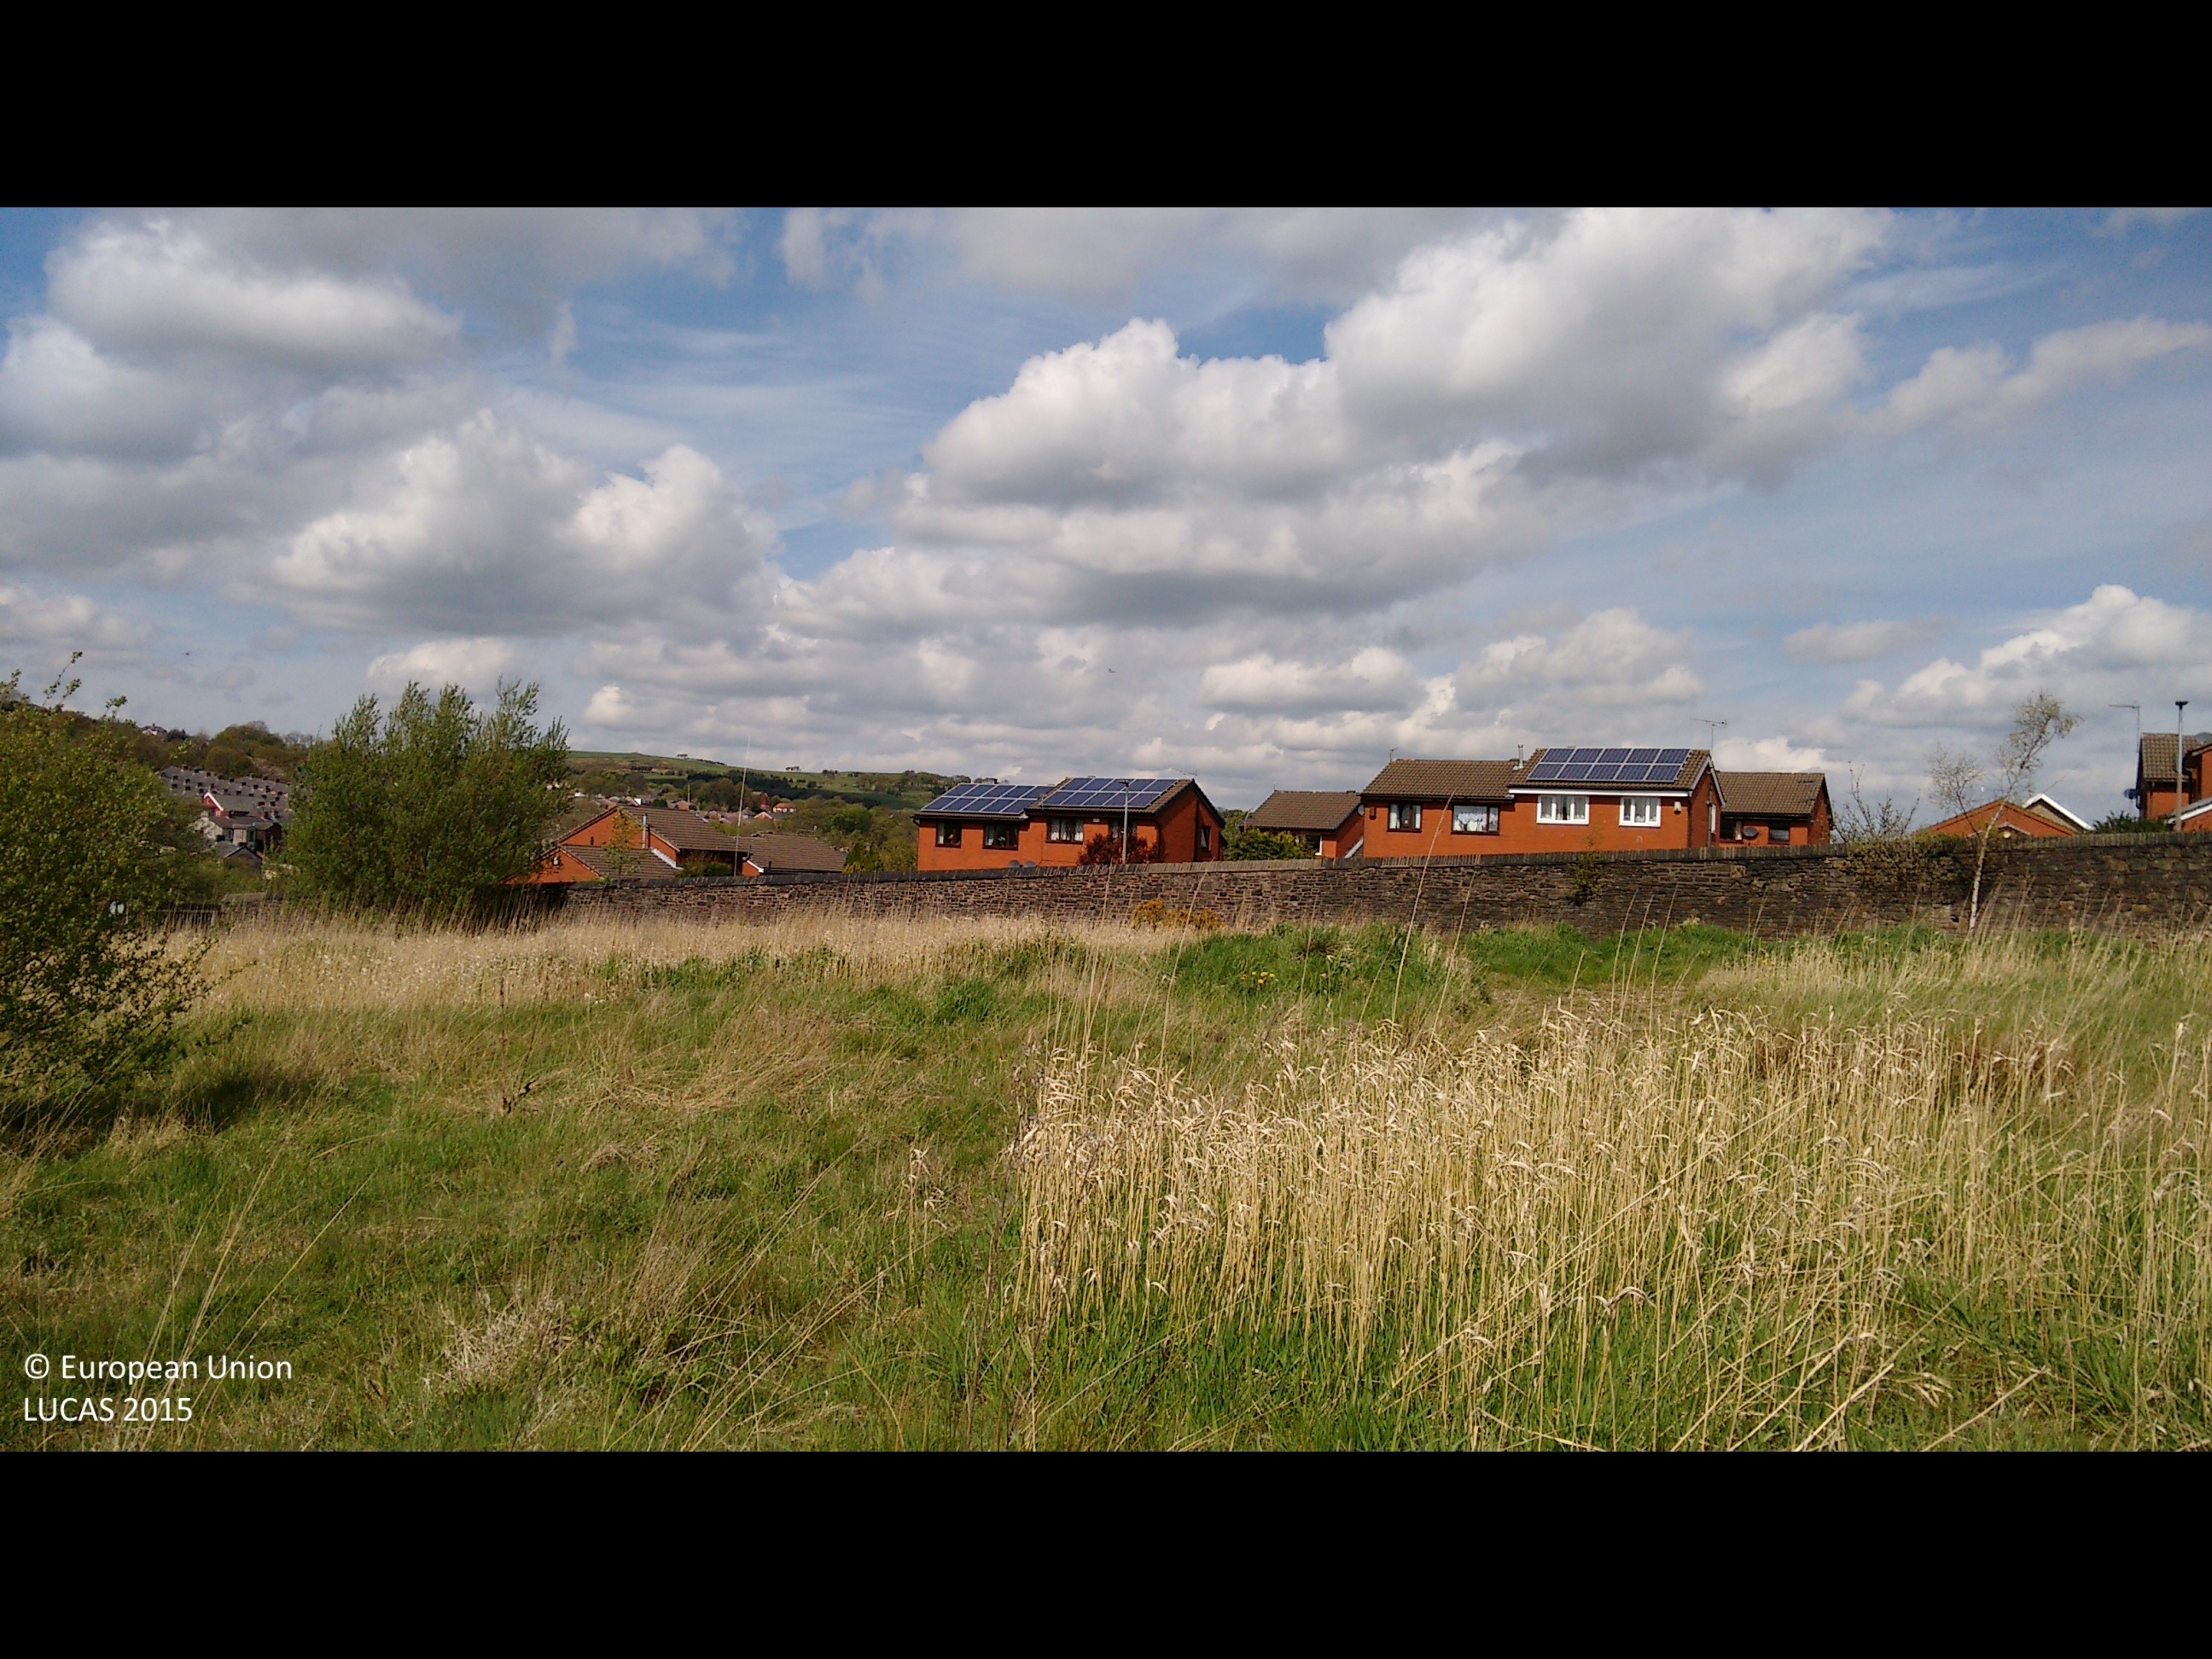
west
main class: Grassland
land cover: Grassland without tree/shrub cover
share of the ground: > 75 %
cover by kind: herbaceous plants 100 %
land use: Semi-natural and natural areas not in use
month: May
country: GB
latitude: 53.7008
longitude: -2.4702
